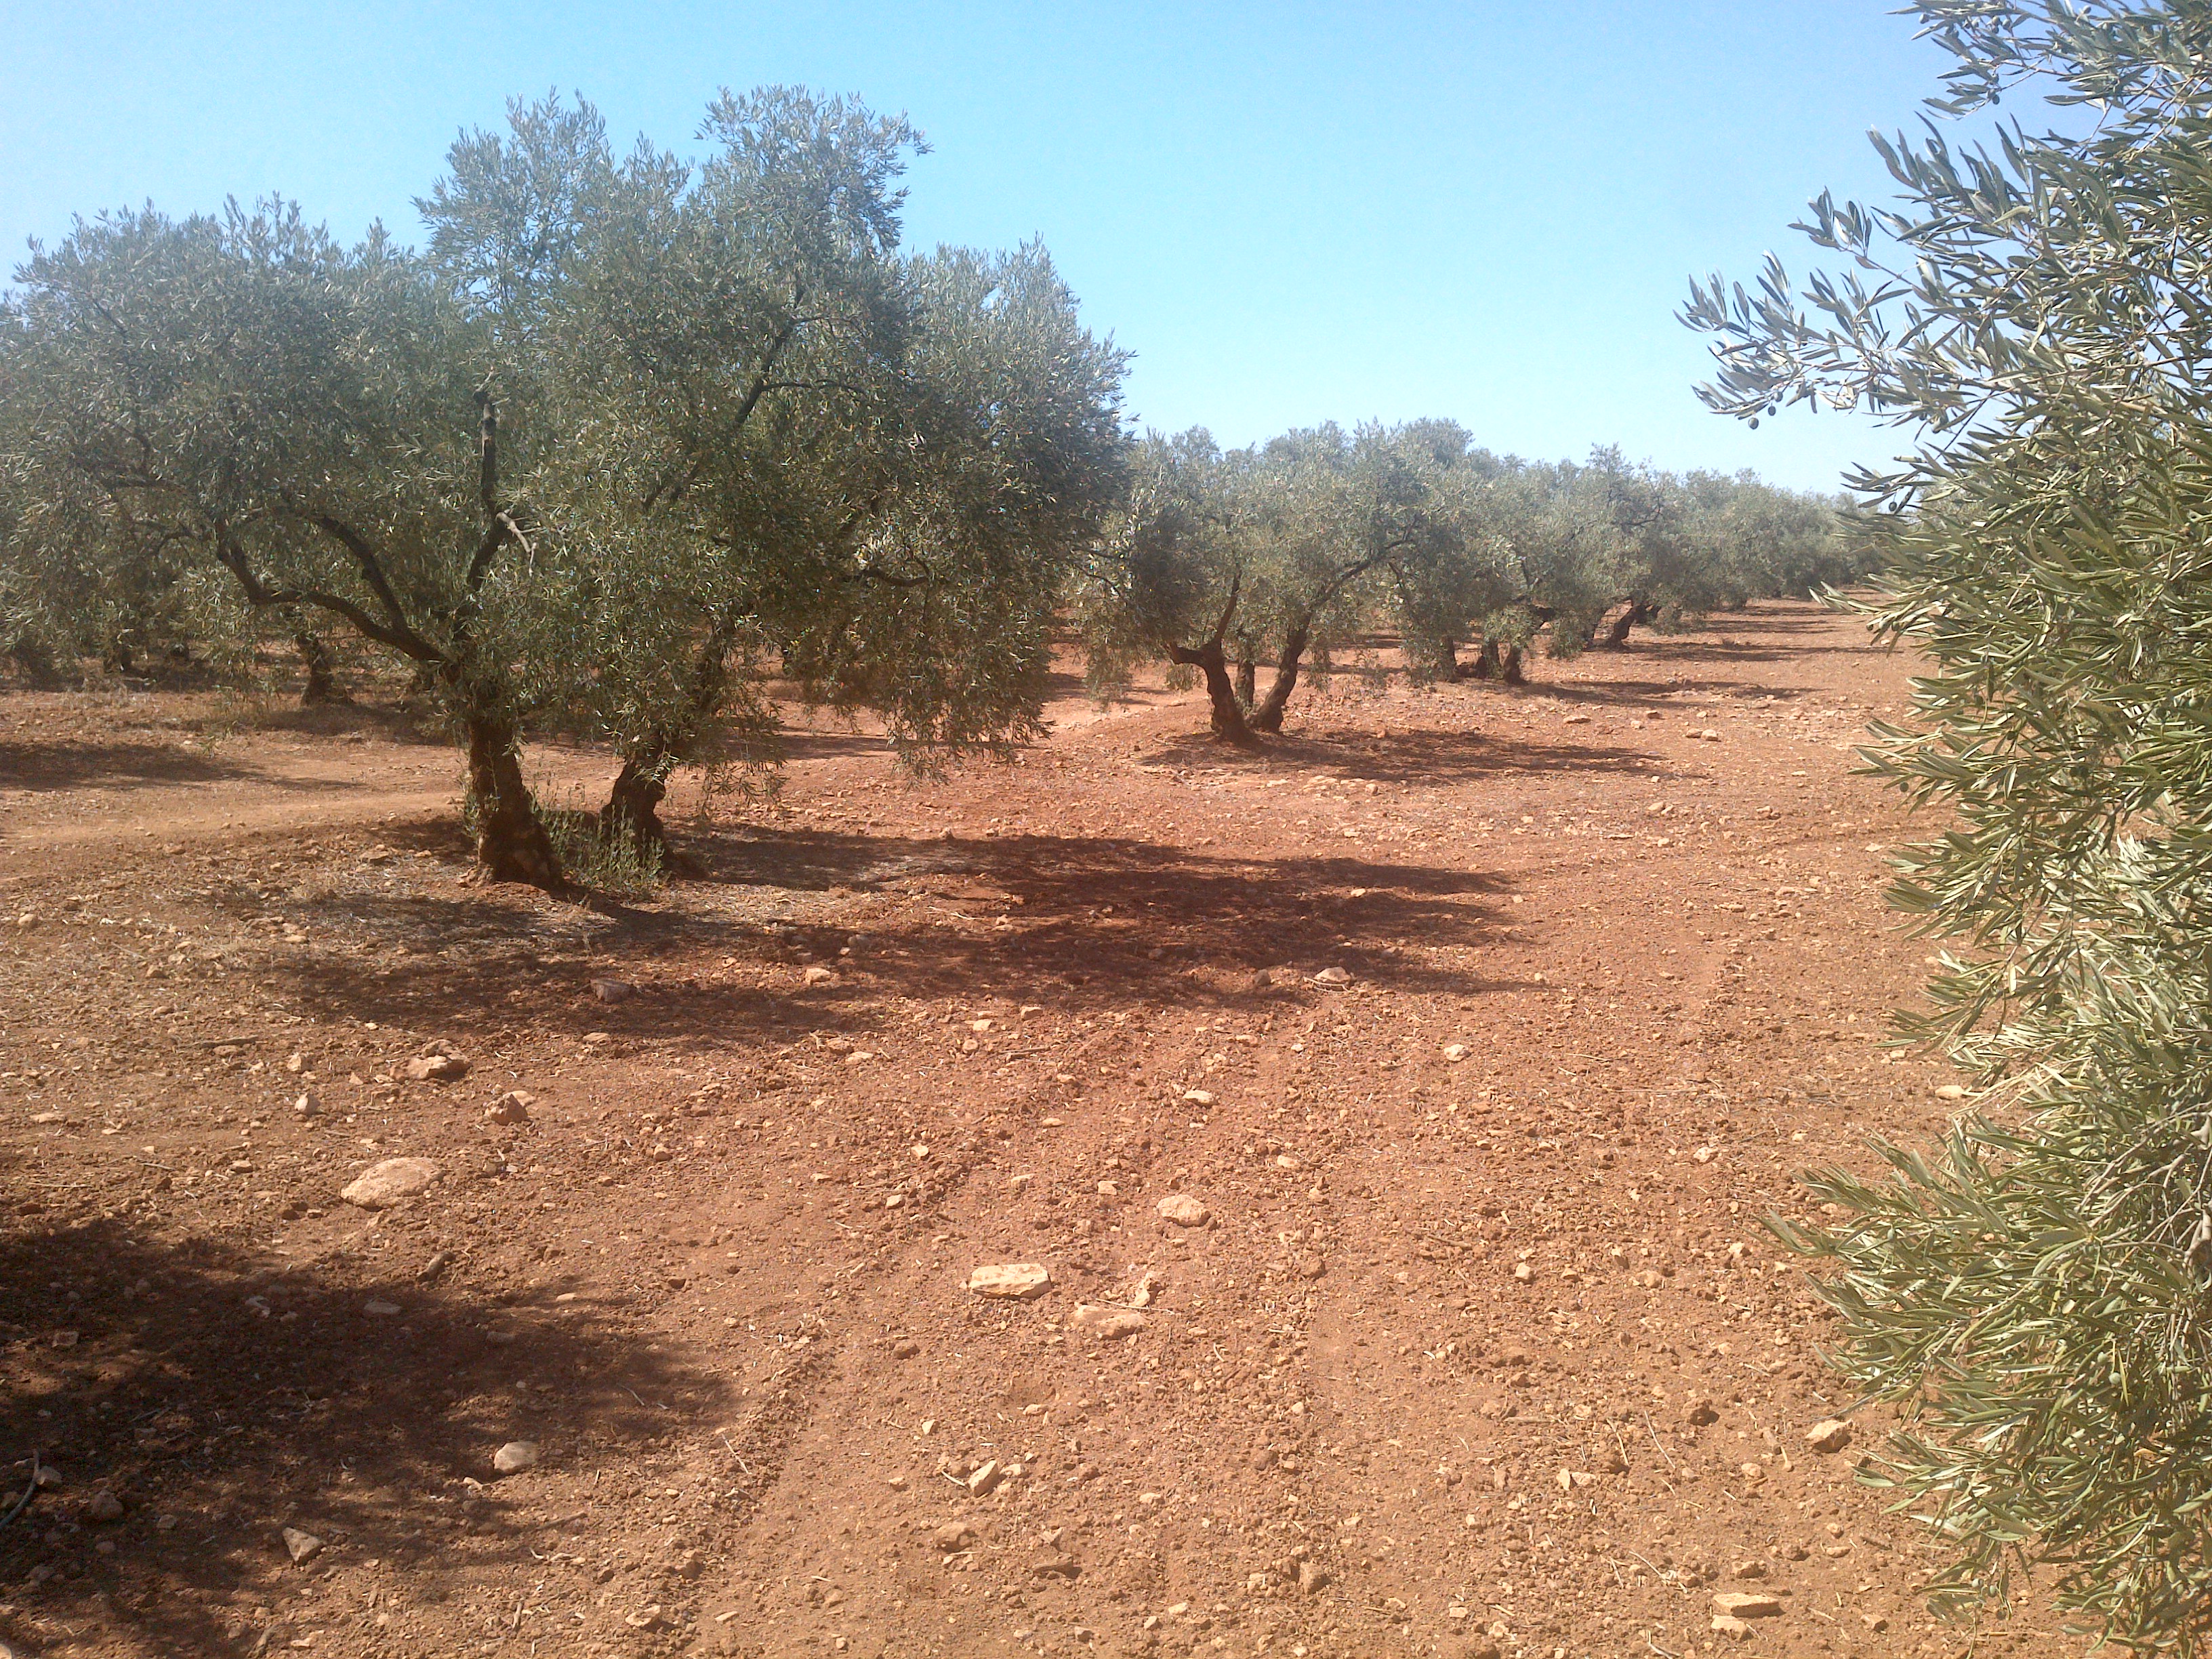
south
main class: Cropland
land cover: Olive groves
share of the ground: 50 - 75 %
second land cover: Other bare soil
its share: > 75 %
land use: Agriculture (excluding fallow land and kitchen gardens)
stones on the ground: 10 - 25 %
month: July
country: ES
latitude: 37.3898
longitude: -4.8141
